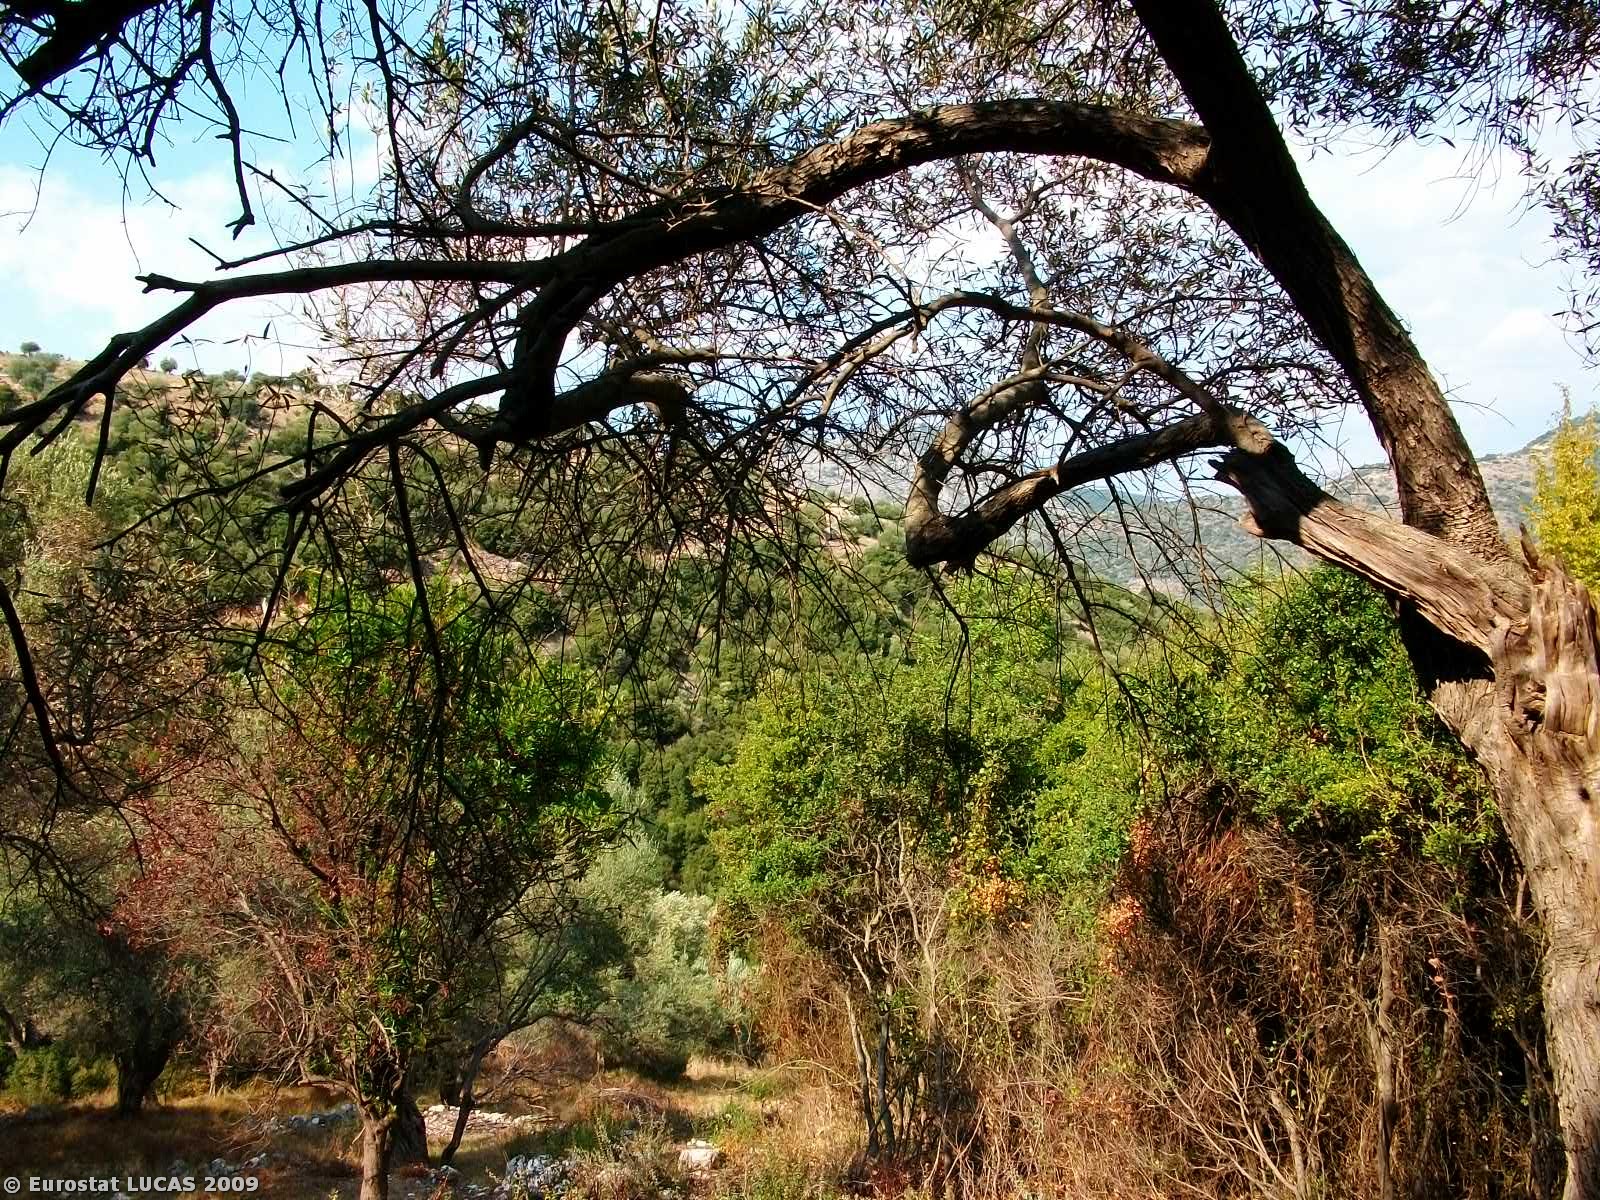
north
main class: Shrubland
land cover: Shrubland without tree cover
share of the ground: > 75 %
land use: Unused
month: September
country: GR
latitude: 39.4702
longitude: 20.2841
